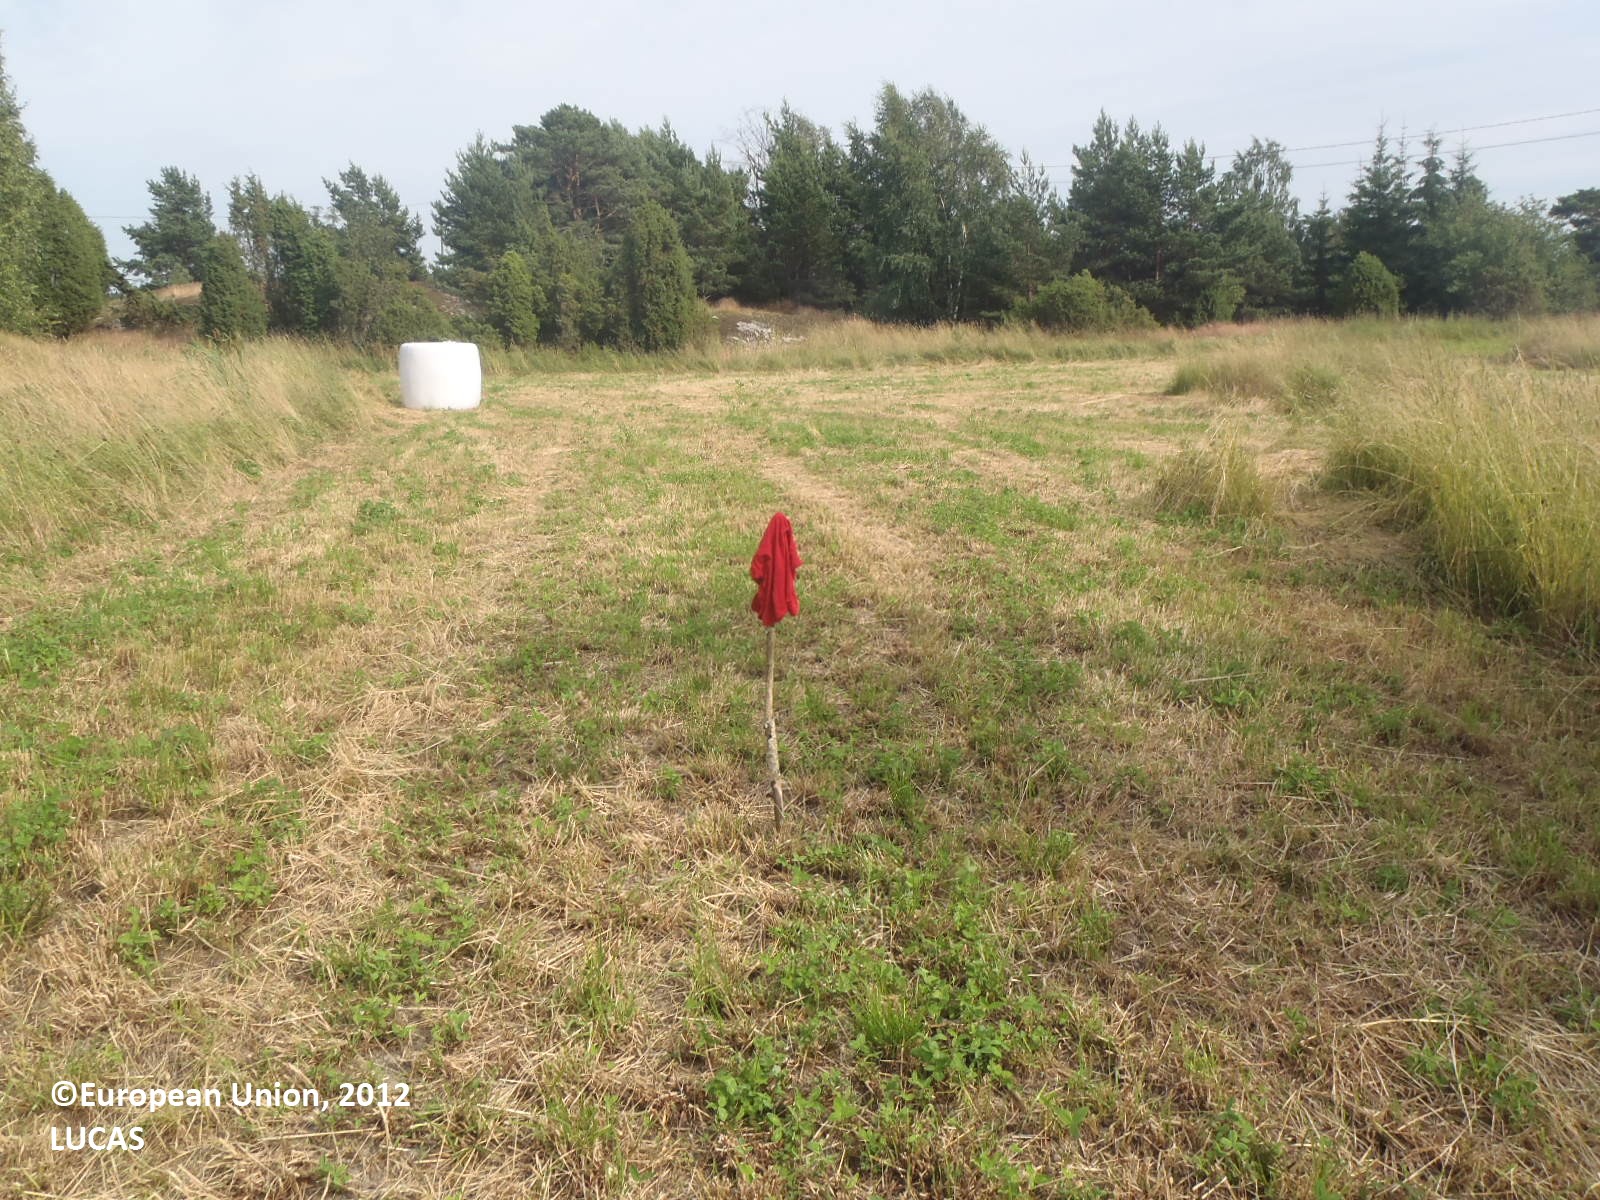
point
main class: Cropland
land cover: Temporary grasslands
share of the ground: > 75 %
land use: Agriculture (excluding fallow land and kitchen gardens)
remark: Harvested field
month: July
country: FI
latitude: 60.3646
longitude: 21.9383
